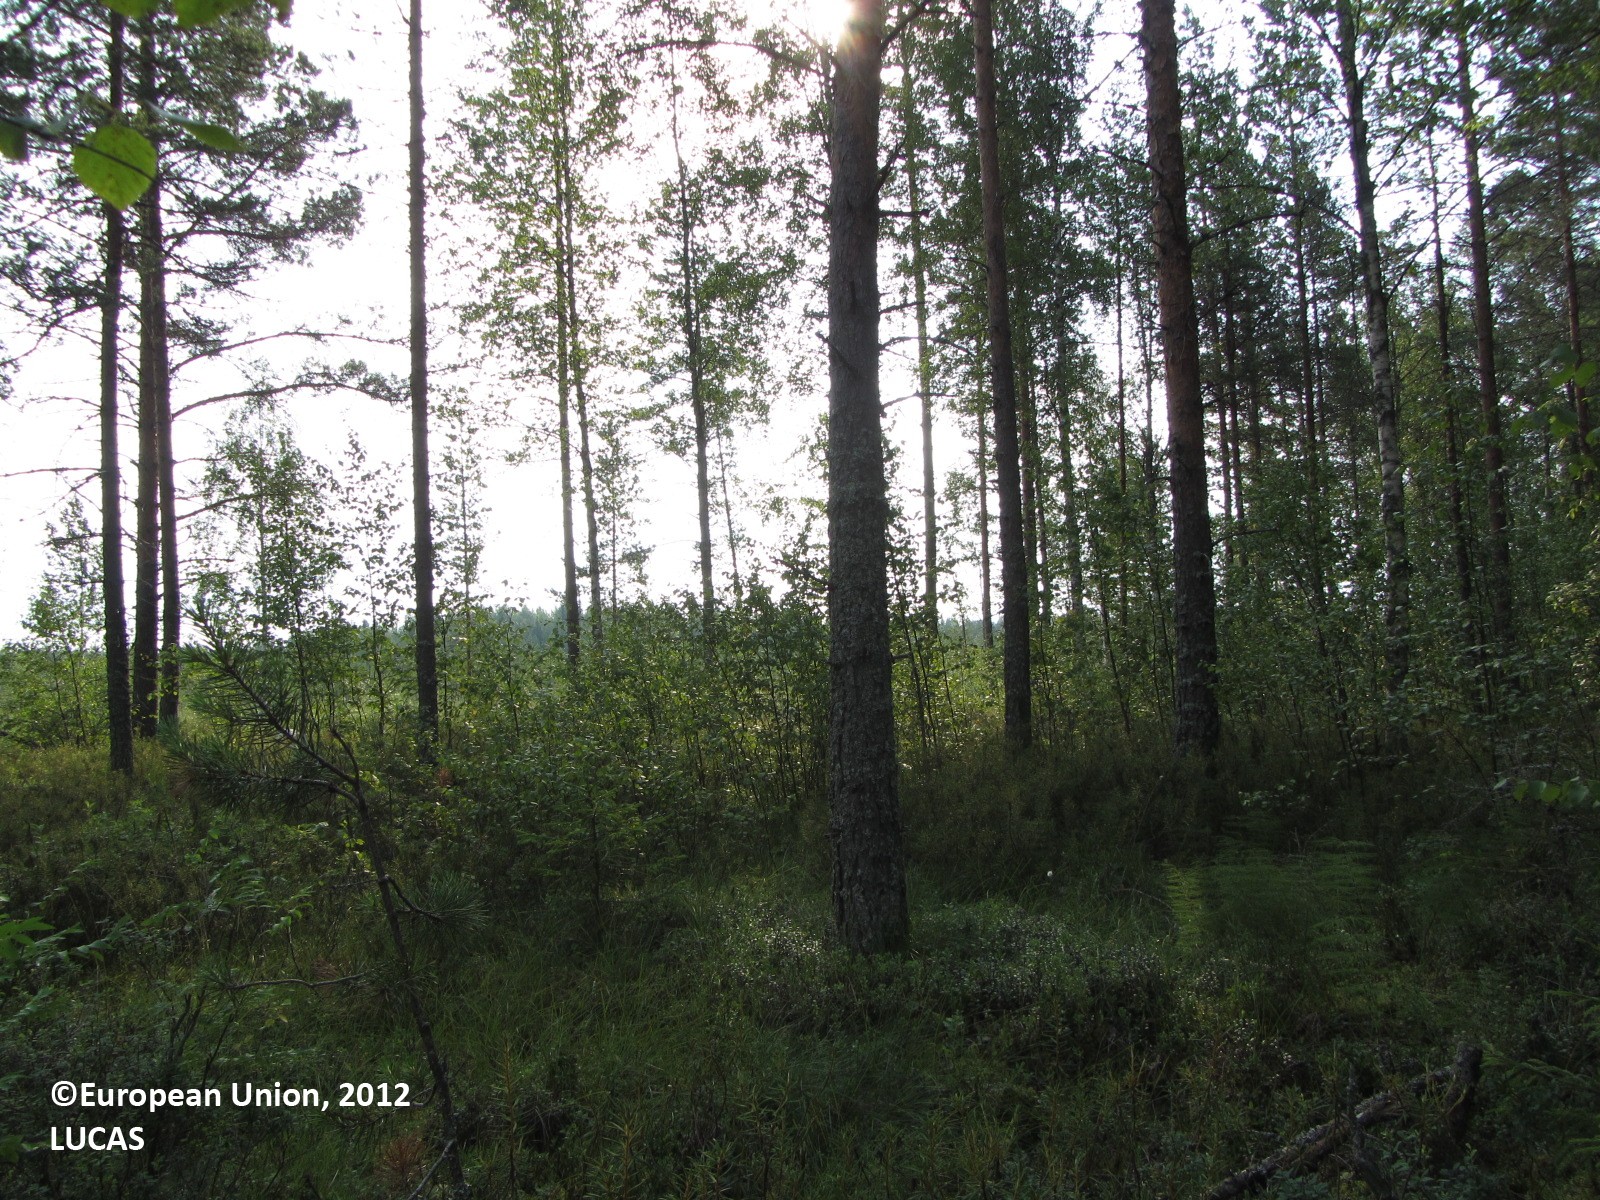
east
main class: Woodland
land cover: Pine dominated mixed woodland
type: boreal forest
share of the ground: 50 - 75 %
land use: Forestry
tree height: > 5 m
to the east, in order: Pine dominated mixed woodland; Shrubland with sparse tree cover; Ditches and canals; Peatbogs; Ditches and canals; Pine dominated coniferous woodland
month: July
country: FI
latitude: 63.5742
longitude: 24.5611
